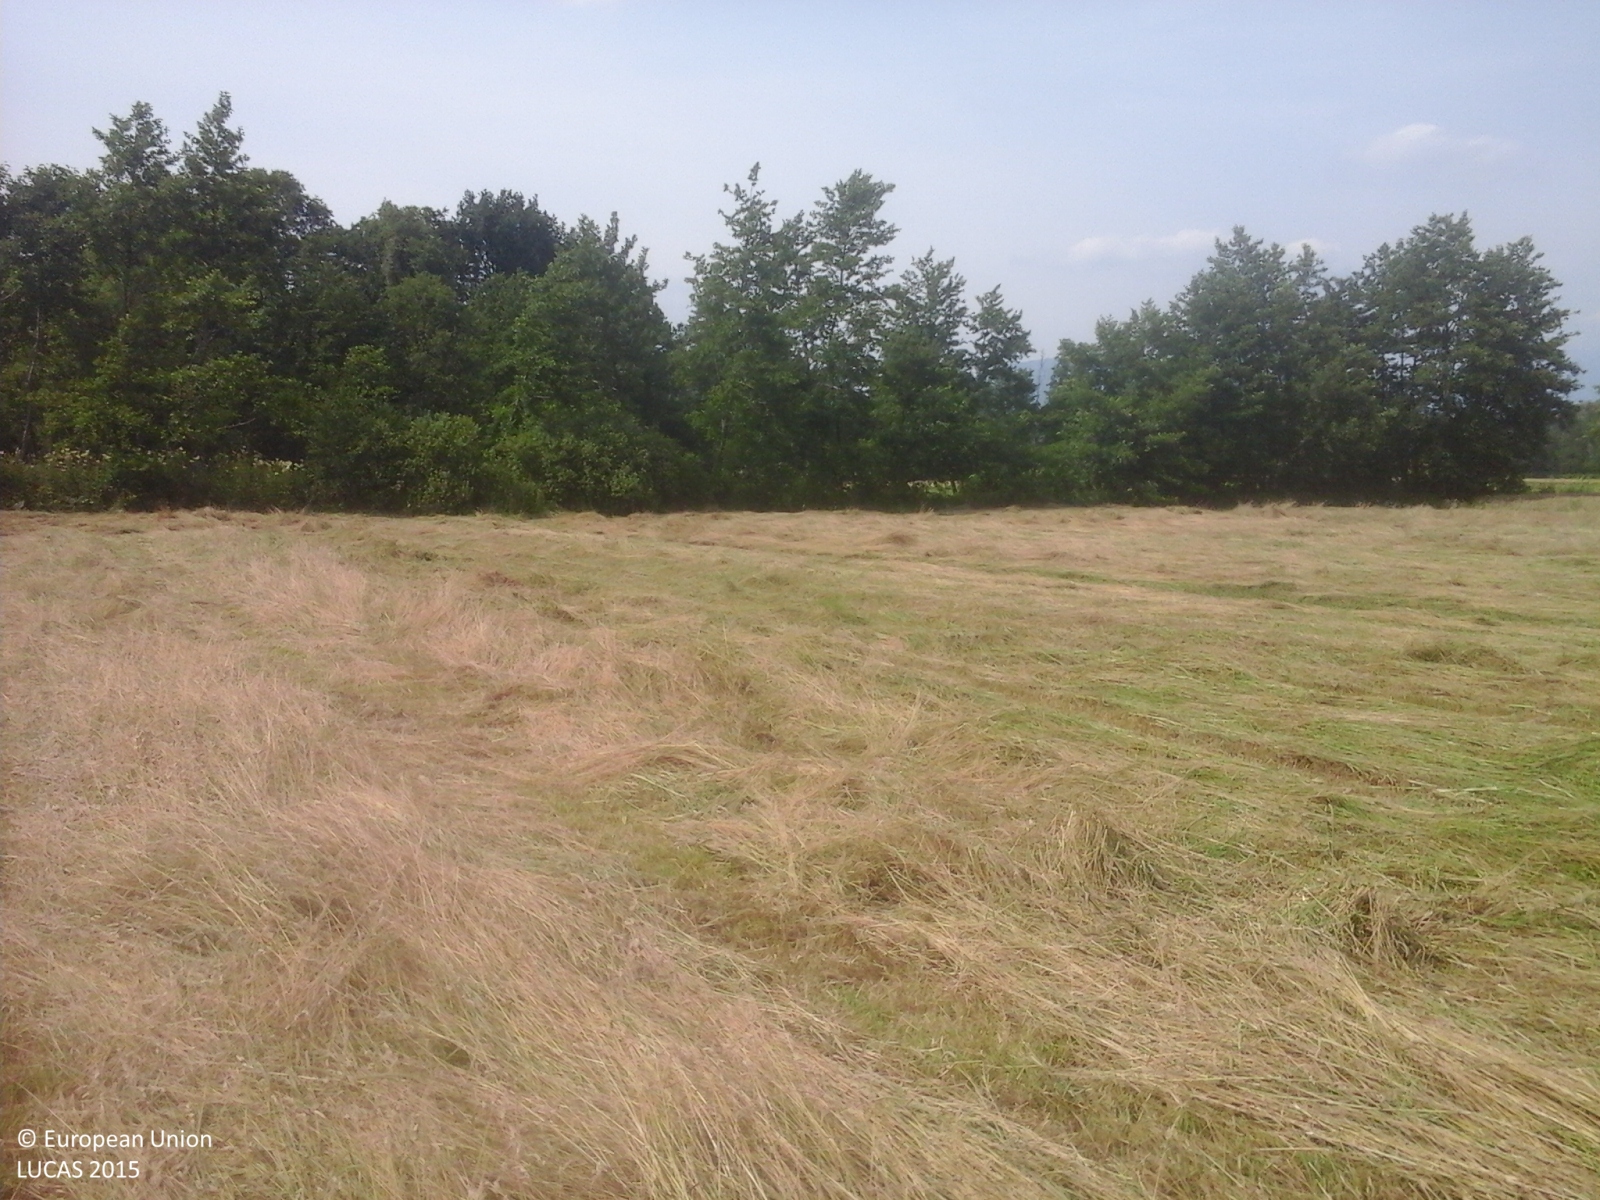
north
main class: Grassland
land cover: Grassland without tree/shrub cover
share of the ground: > 75 %
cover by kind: herbaceous plants 100 %
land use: Agriculture (excluding fallow land and kitchen gardens)
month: June
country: IT
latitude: 45.7183
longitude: 9.2945
